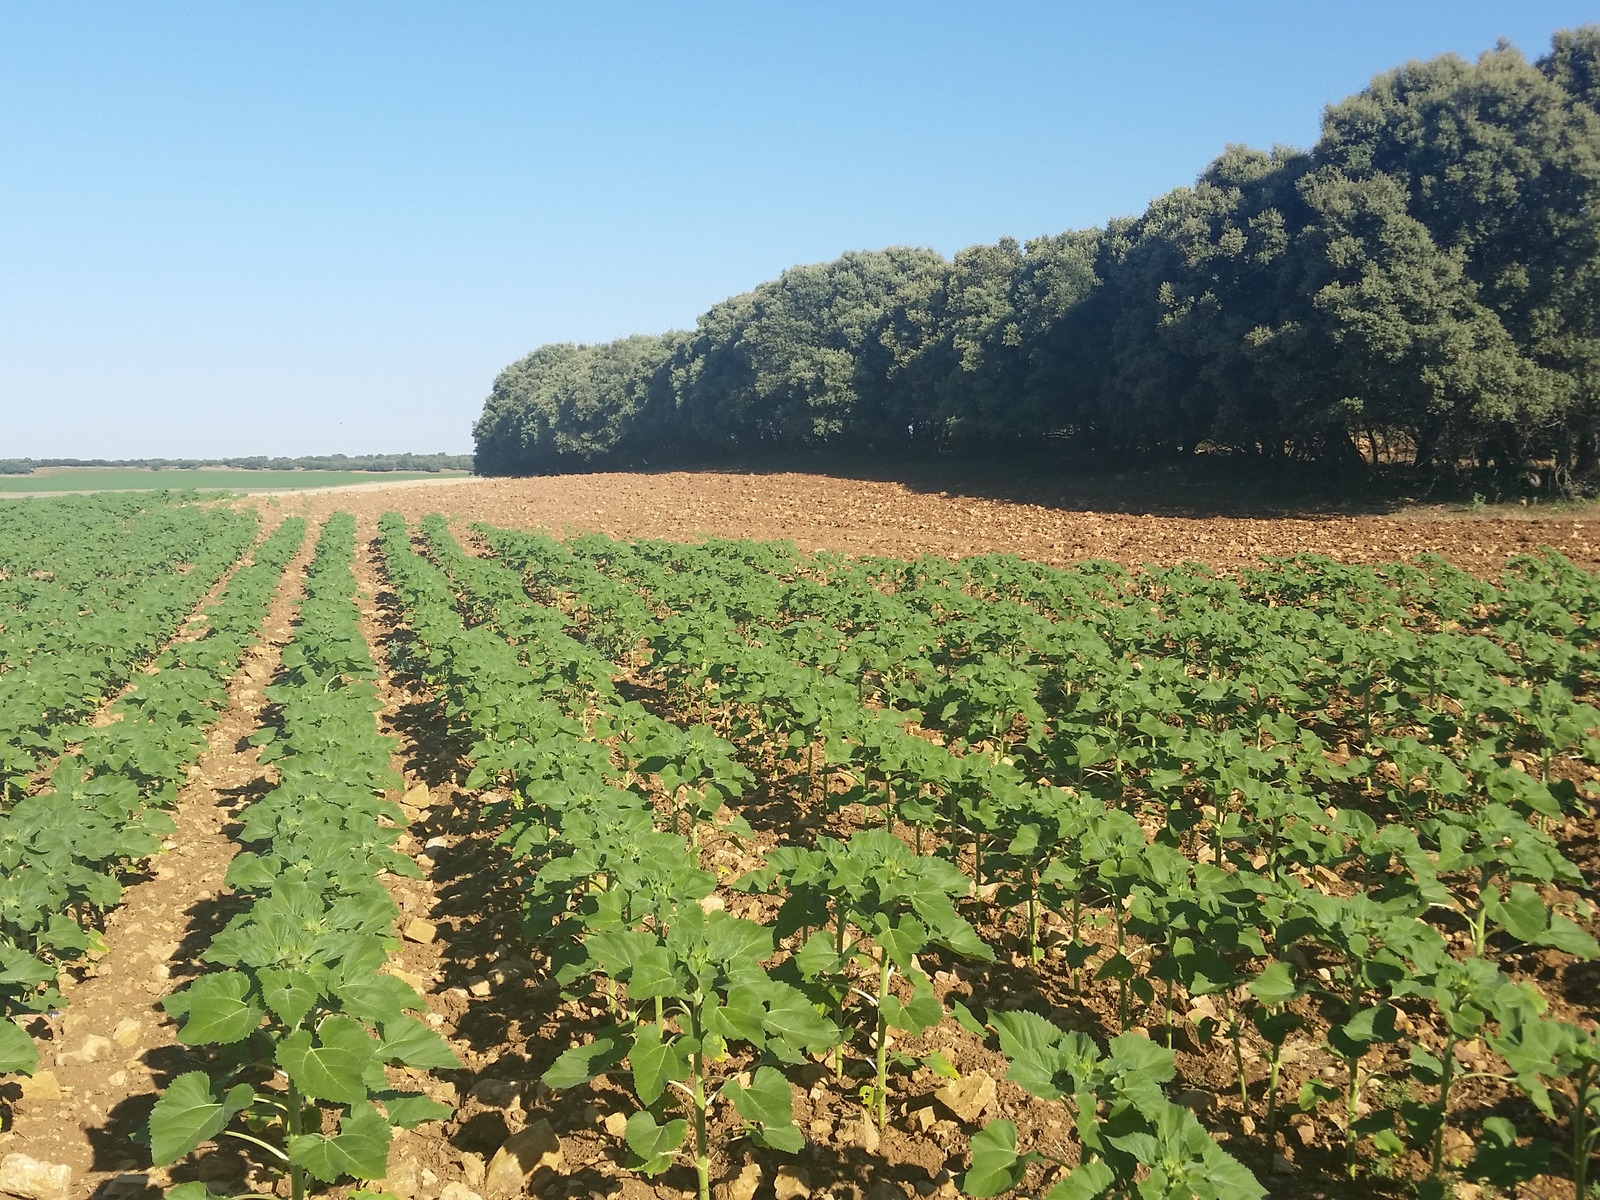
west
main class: Cropland
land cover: Sunflower
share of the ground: > 75 %
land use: Agriculture (excluding fallow land and kitchen gardens)
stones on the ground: 10 - 25 %
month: June
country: ES
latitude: 38.7348
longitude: -2.4837
